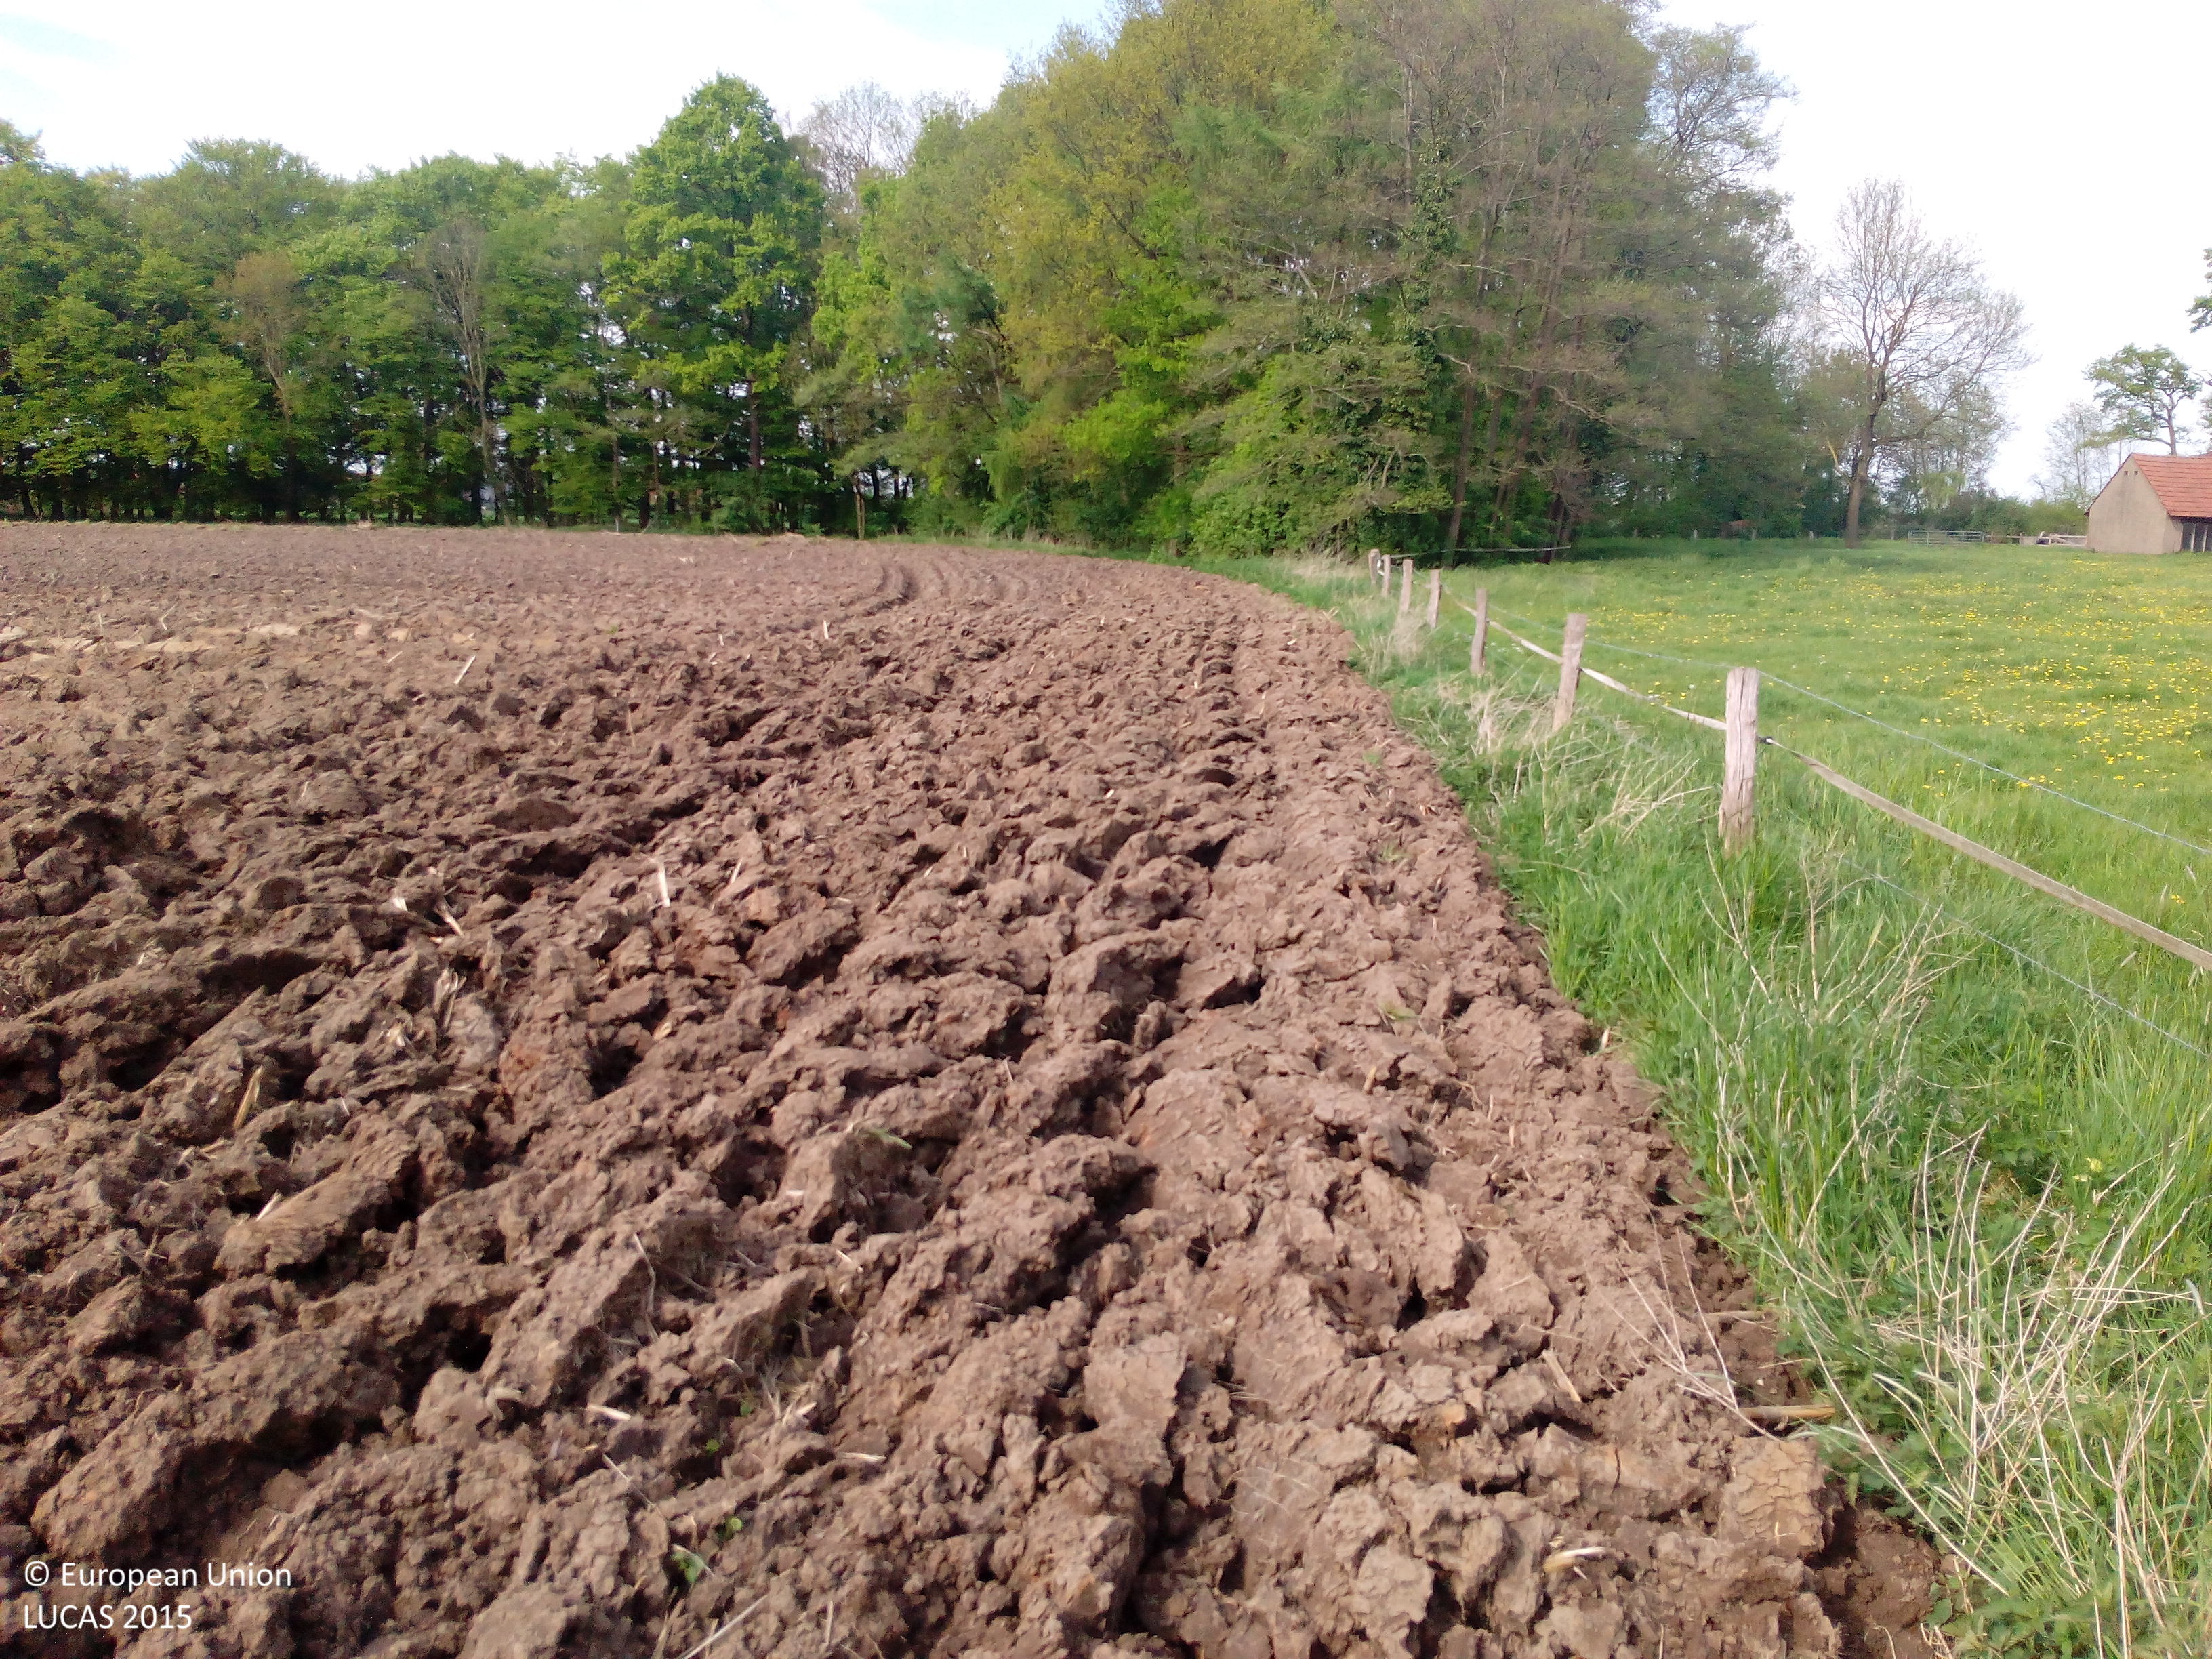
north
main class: Cropland
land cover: Maize
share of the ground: < 10 %
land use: Agriculture (excluding fallow land and kitchen gardens)
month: May
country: DE
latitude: 51.8276
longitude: 7.4030
